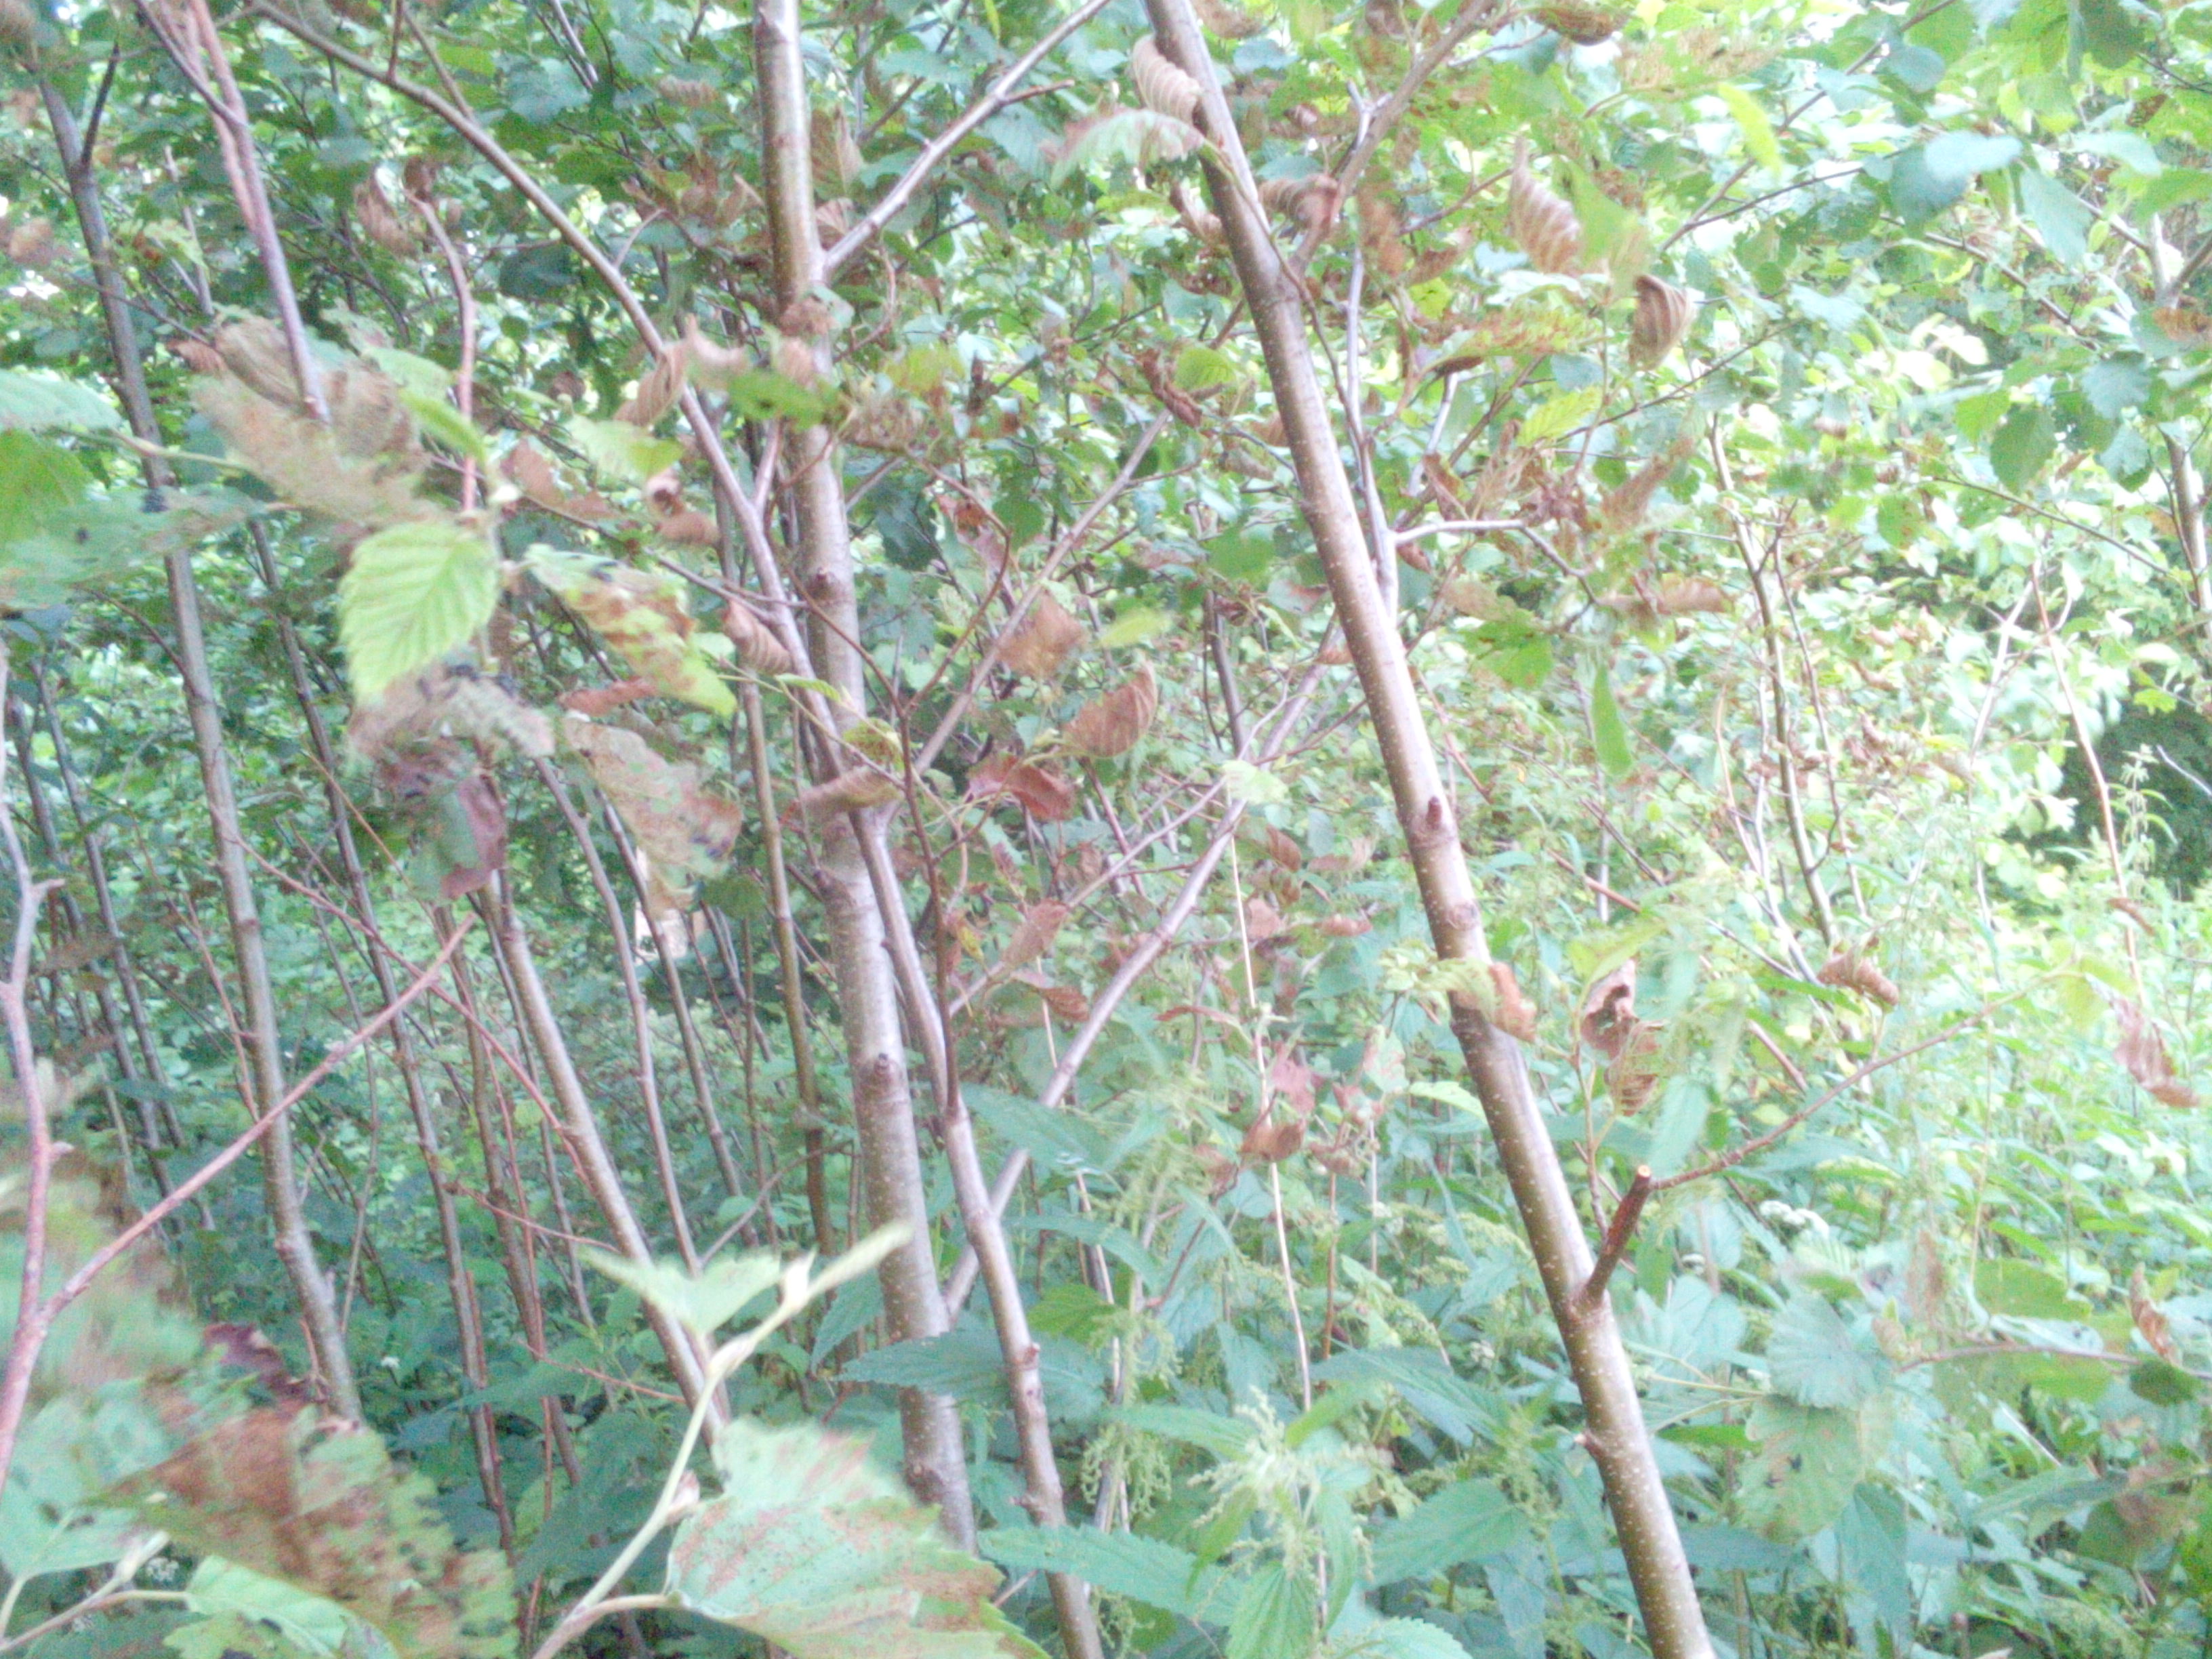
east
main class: Woodland
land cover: Broadleaved woodland
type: non-riverine alder, birch or aspen forest
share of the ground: 50 - 75 %
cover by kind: broadleaved forest trees 65 %, herbaceous plants 35 %
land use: Semi-natural and natural areas not in use
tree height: > 5 m
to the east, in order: Broadleaved woodland; Inland fresh water bodies; Broadleaved woodland; Spontaneously vegetated surfaces
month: July
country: LV
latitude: 56.5177
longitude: 21.7642
